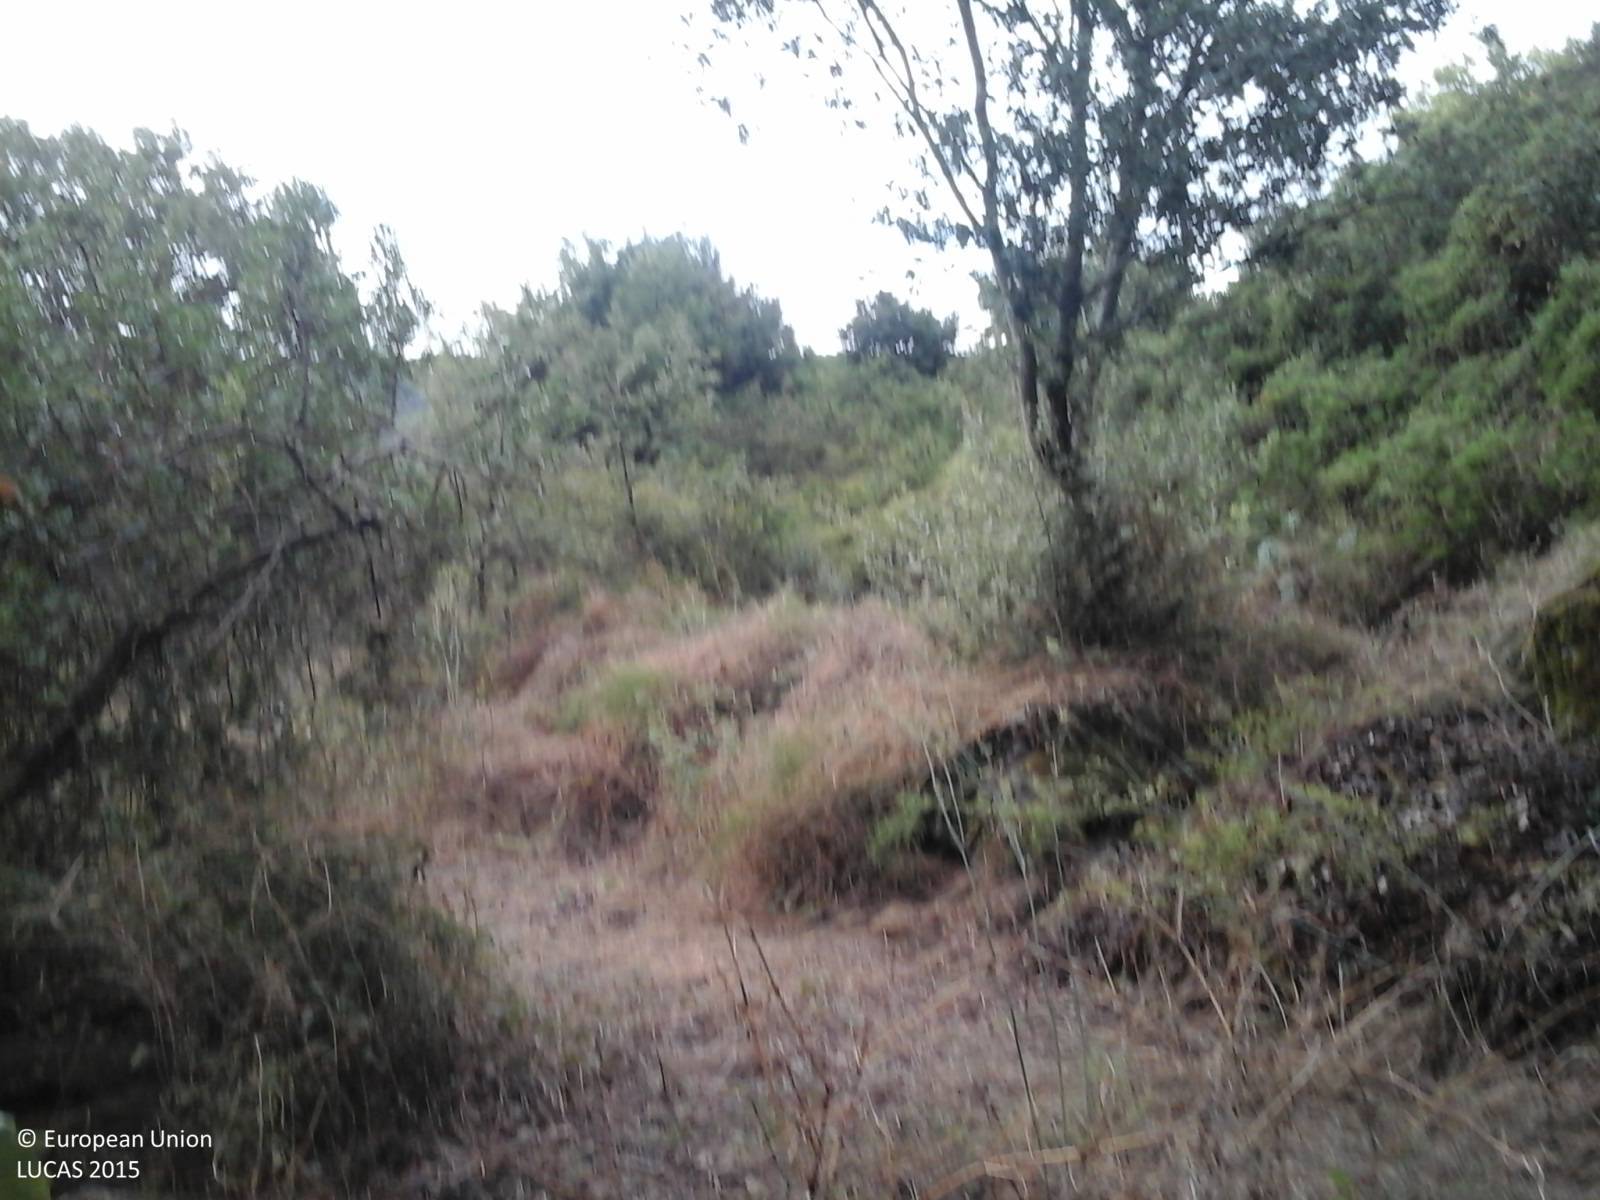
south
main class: Woodland
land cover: Broadleaved woodland
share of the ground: > 75 %
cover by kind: broadleaved forest trees 50 %, herbaceous plants 35 %, shrubs 15 %
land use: Agriculture (excluding fallow land and kitchen gardens)
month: October
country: IT
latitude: 40.0979
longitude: 8.8683
